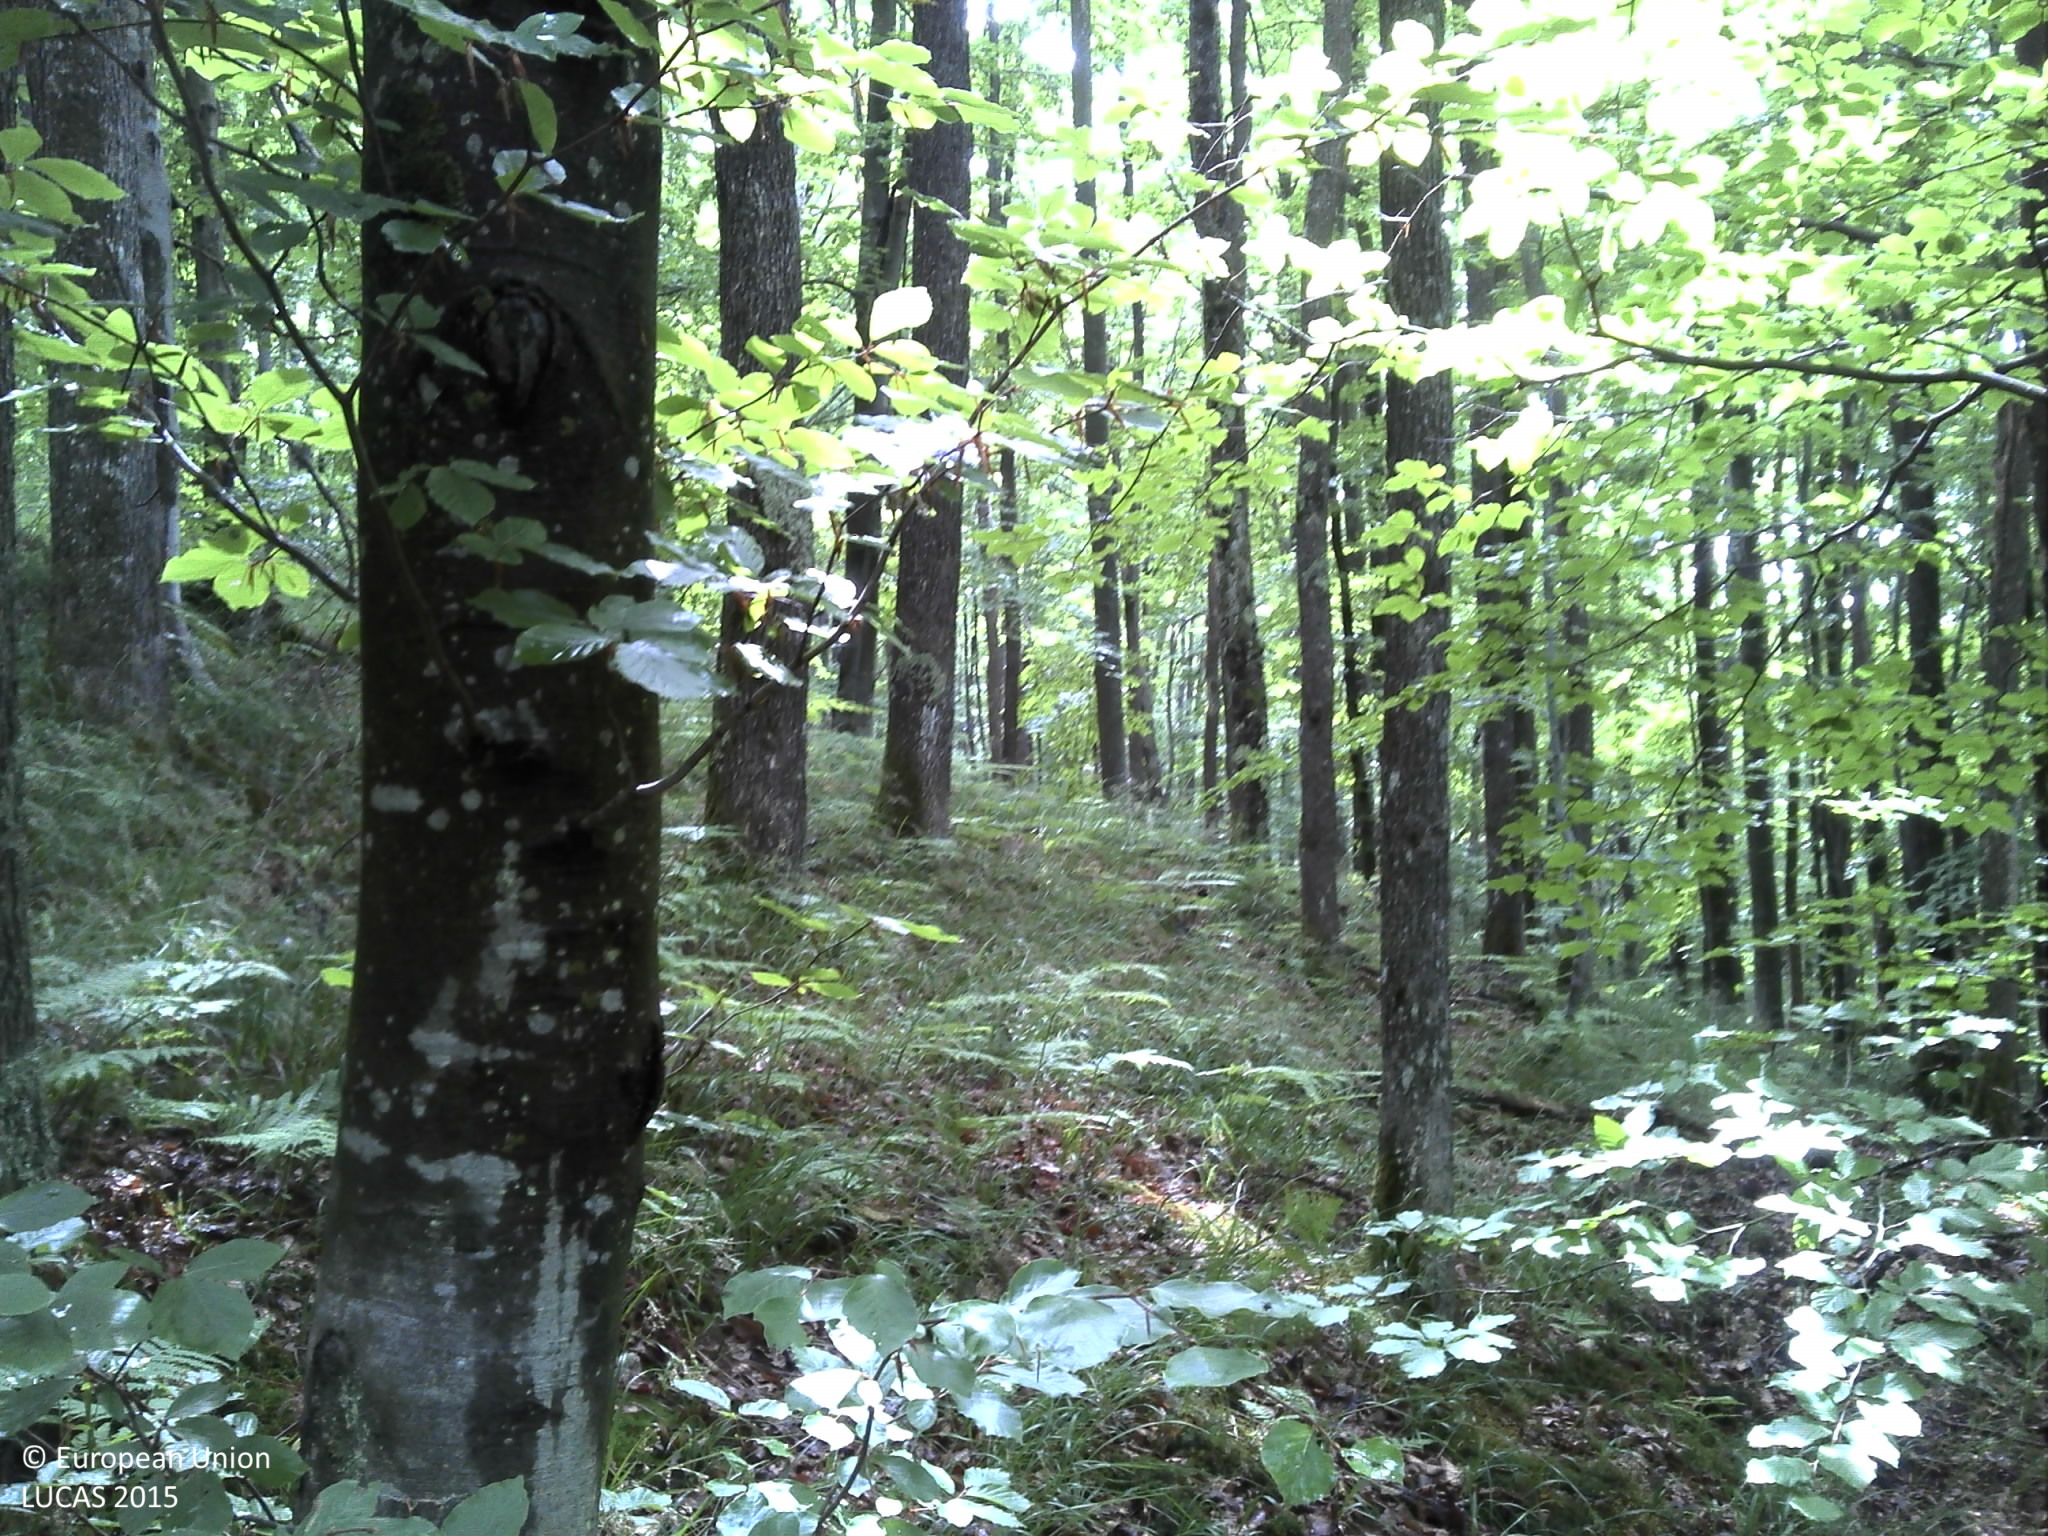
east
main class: Woodland
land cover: Broadleaved woodland
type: beech forest
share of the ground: > 75 %
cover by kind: broadleaved forest trees 80 %, lichens and mosses 20 %
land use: Forestry
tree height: > 5 m
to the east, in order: Broadleaved woodland
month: June
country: HR
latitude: 45.5275
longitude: 17.4918
